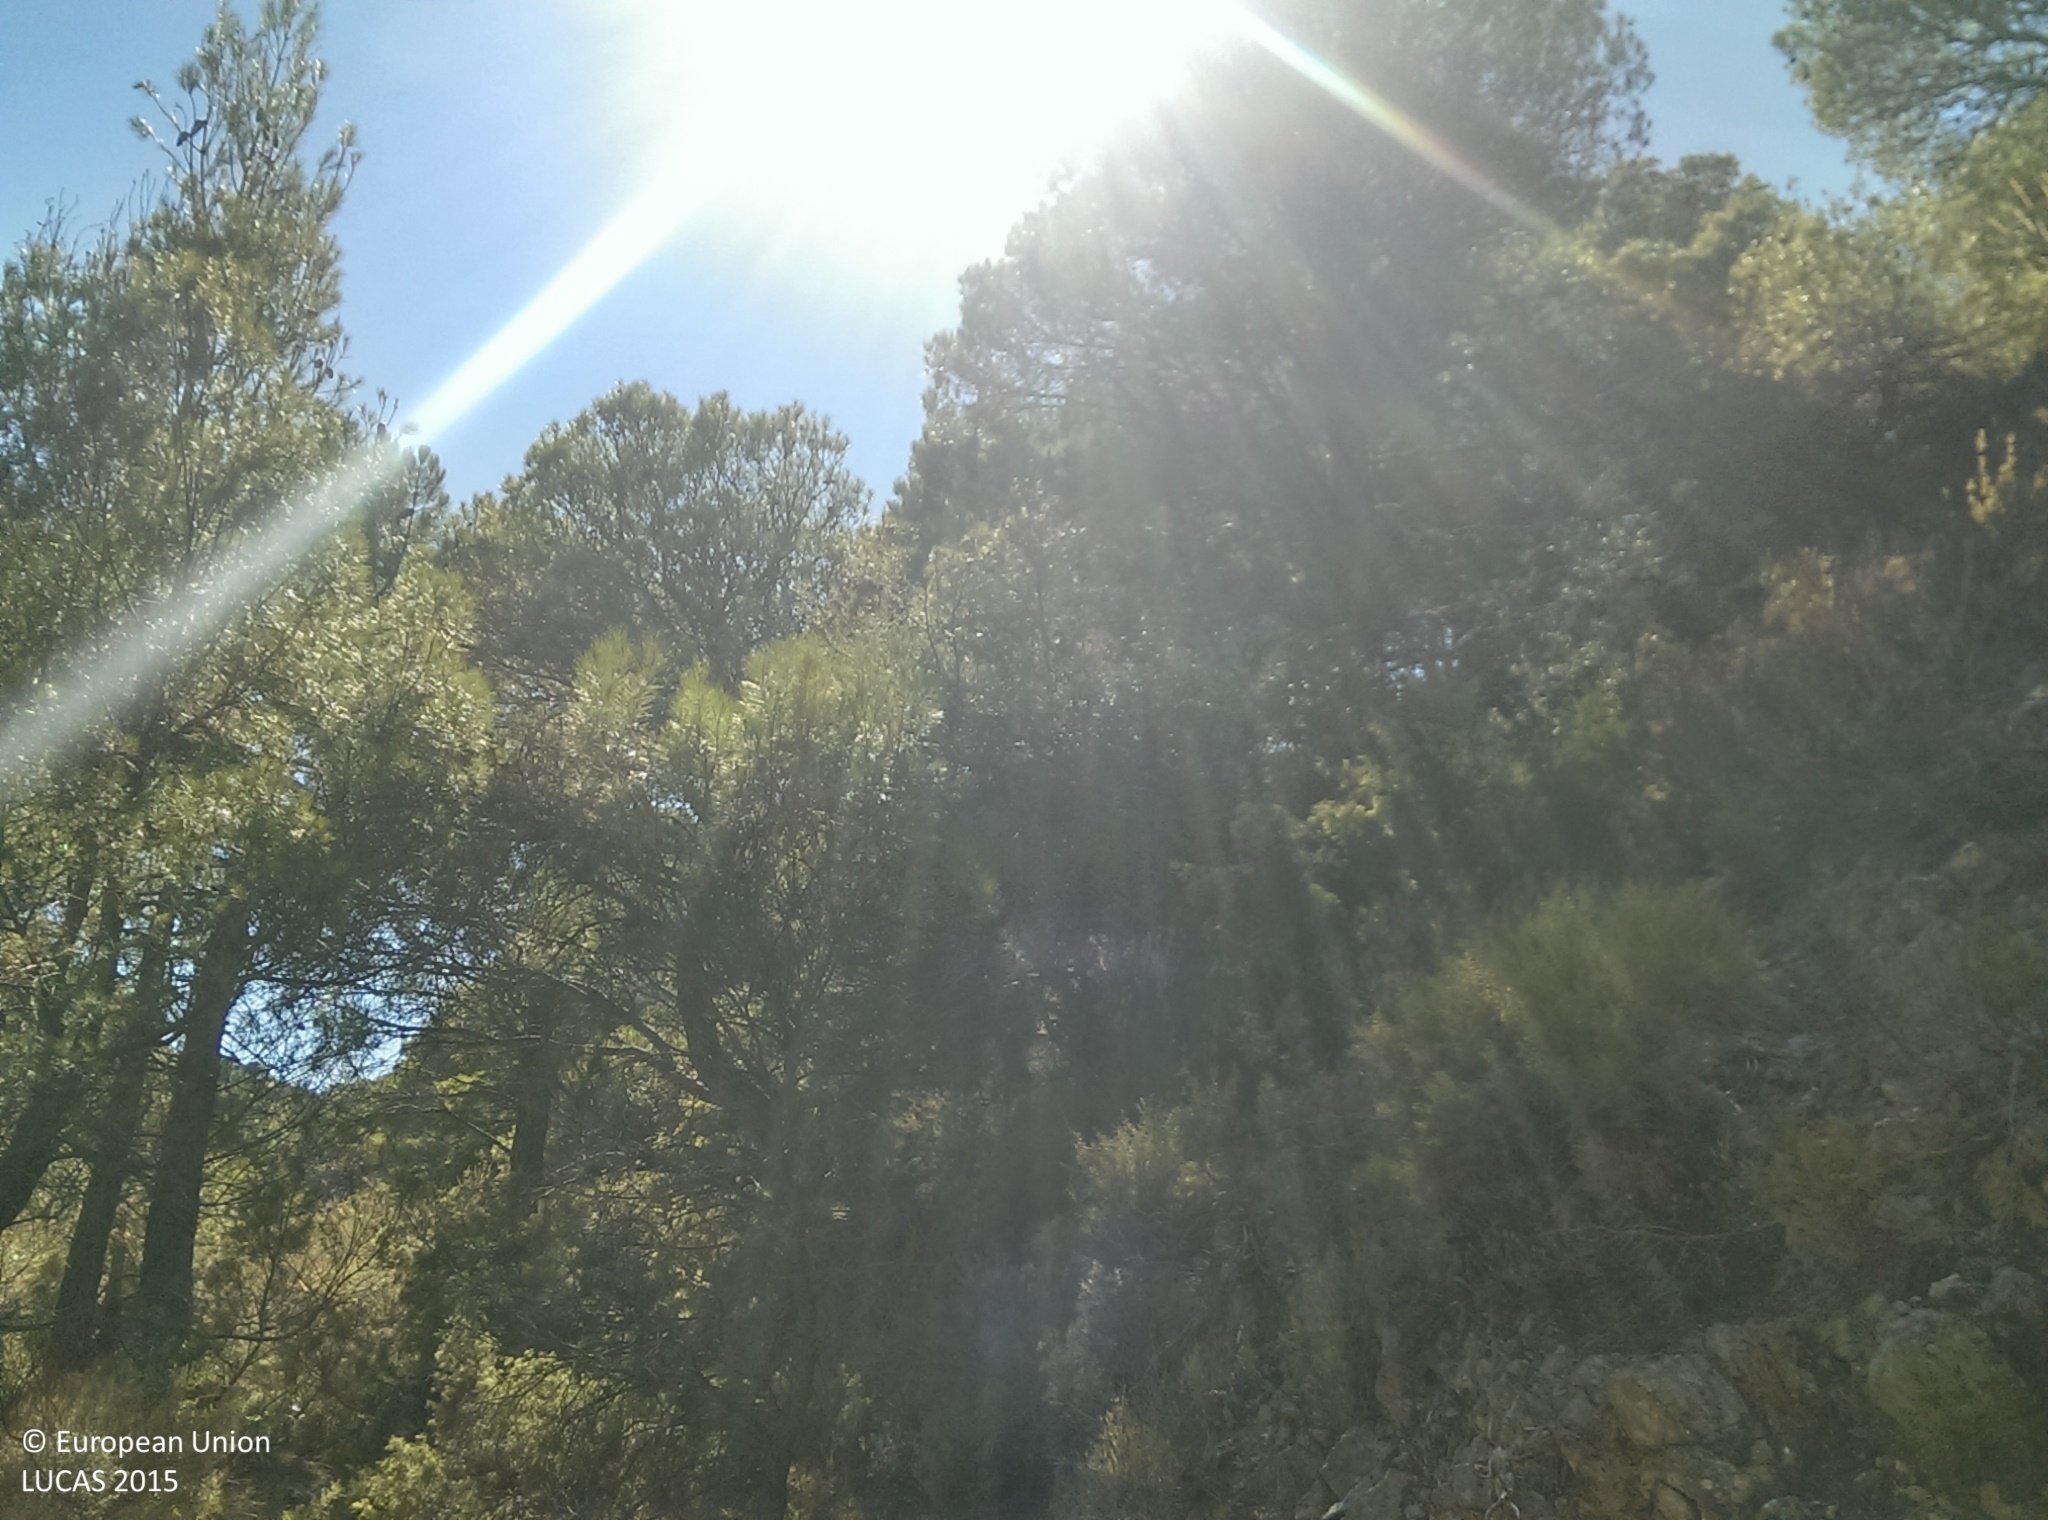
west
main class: Woodland
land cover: Pine dominated coniferous woodland
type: coniferous forest of the mediterranean region
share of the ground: 50 - 75 %
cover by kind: coniferous forest trees 65 %, shrubs 20 %, herbaceous plants 10 %, unconsolidated bare surface 5 %
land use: Forestry
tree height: > 5 m
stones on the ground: > 50 %
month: August
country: ES
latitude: 36.8946
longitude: -3.5963
